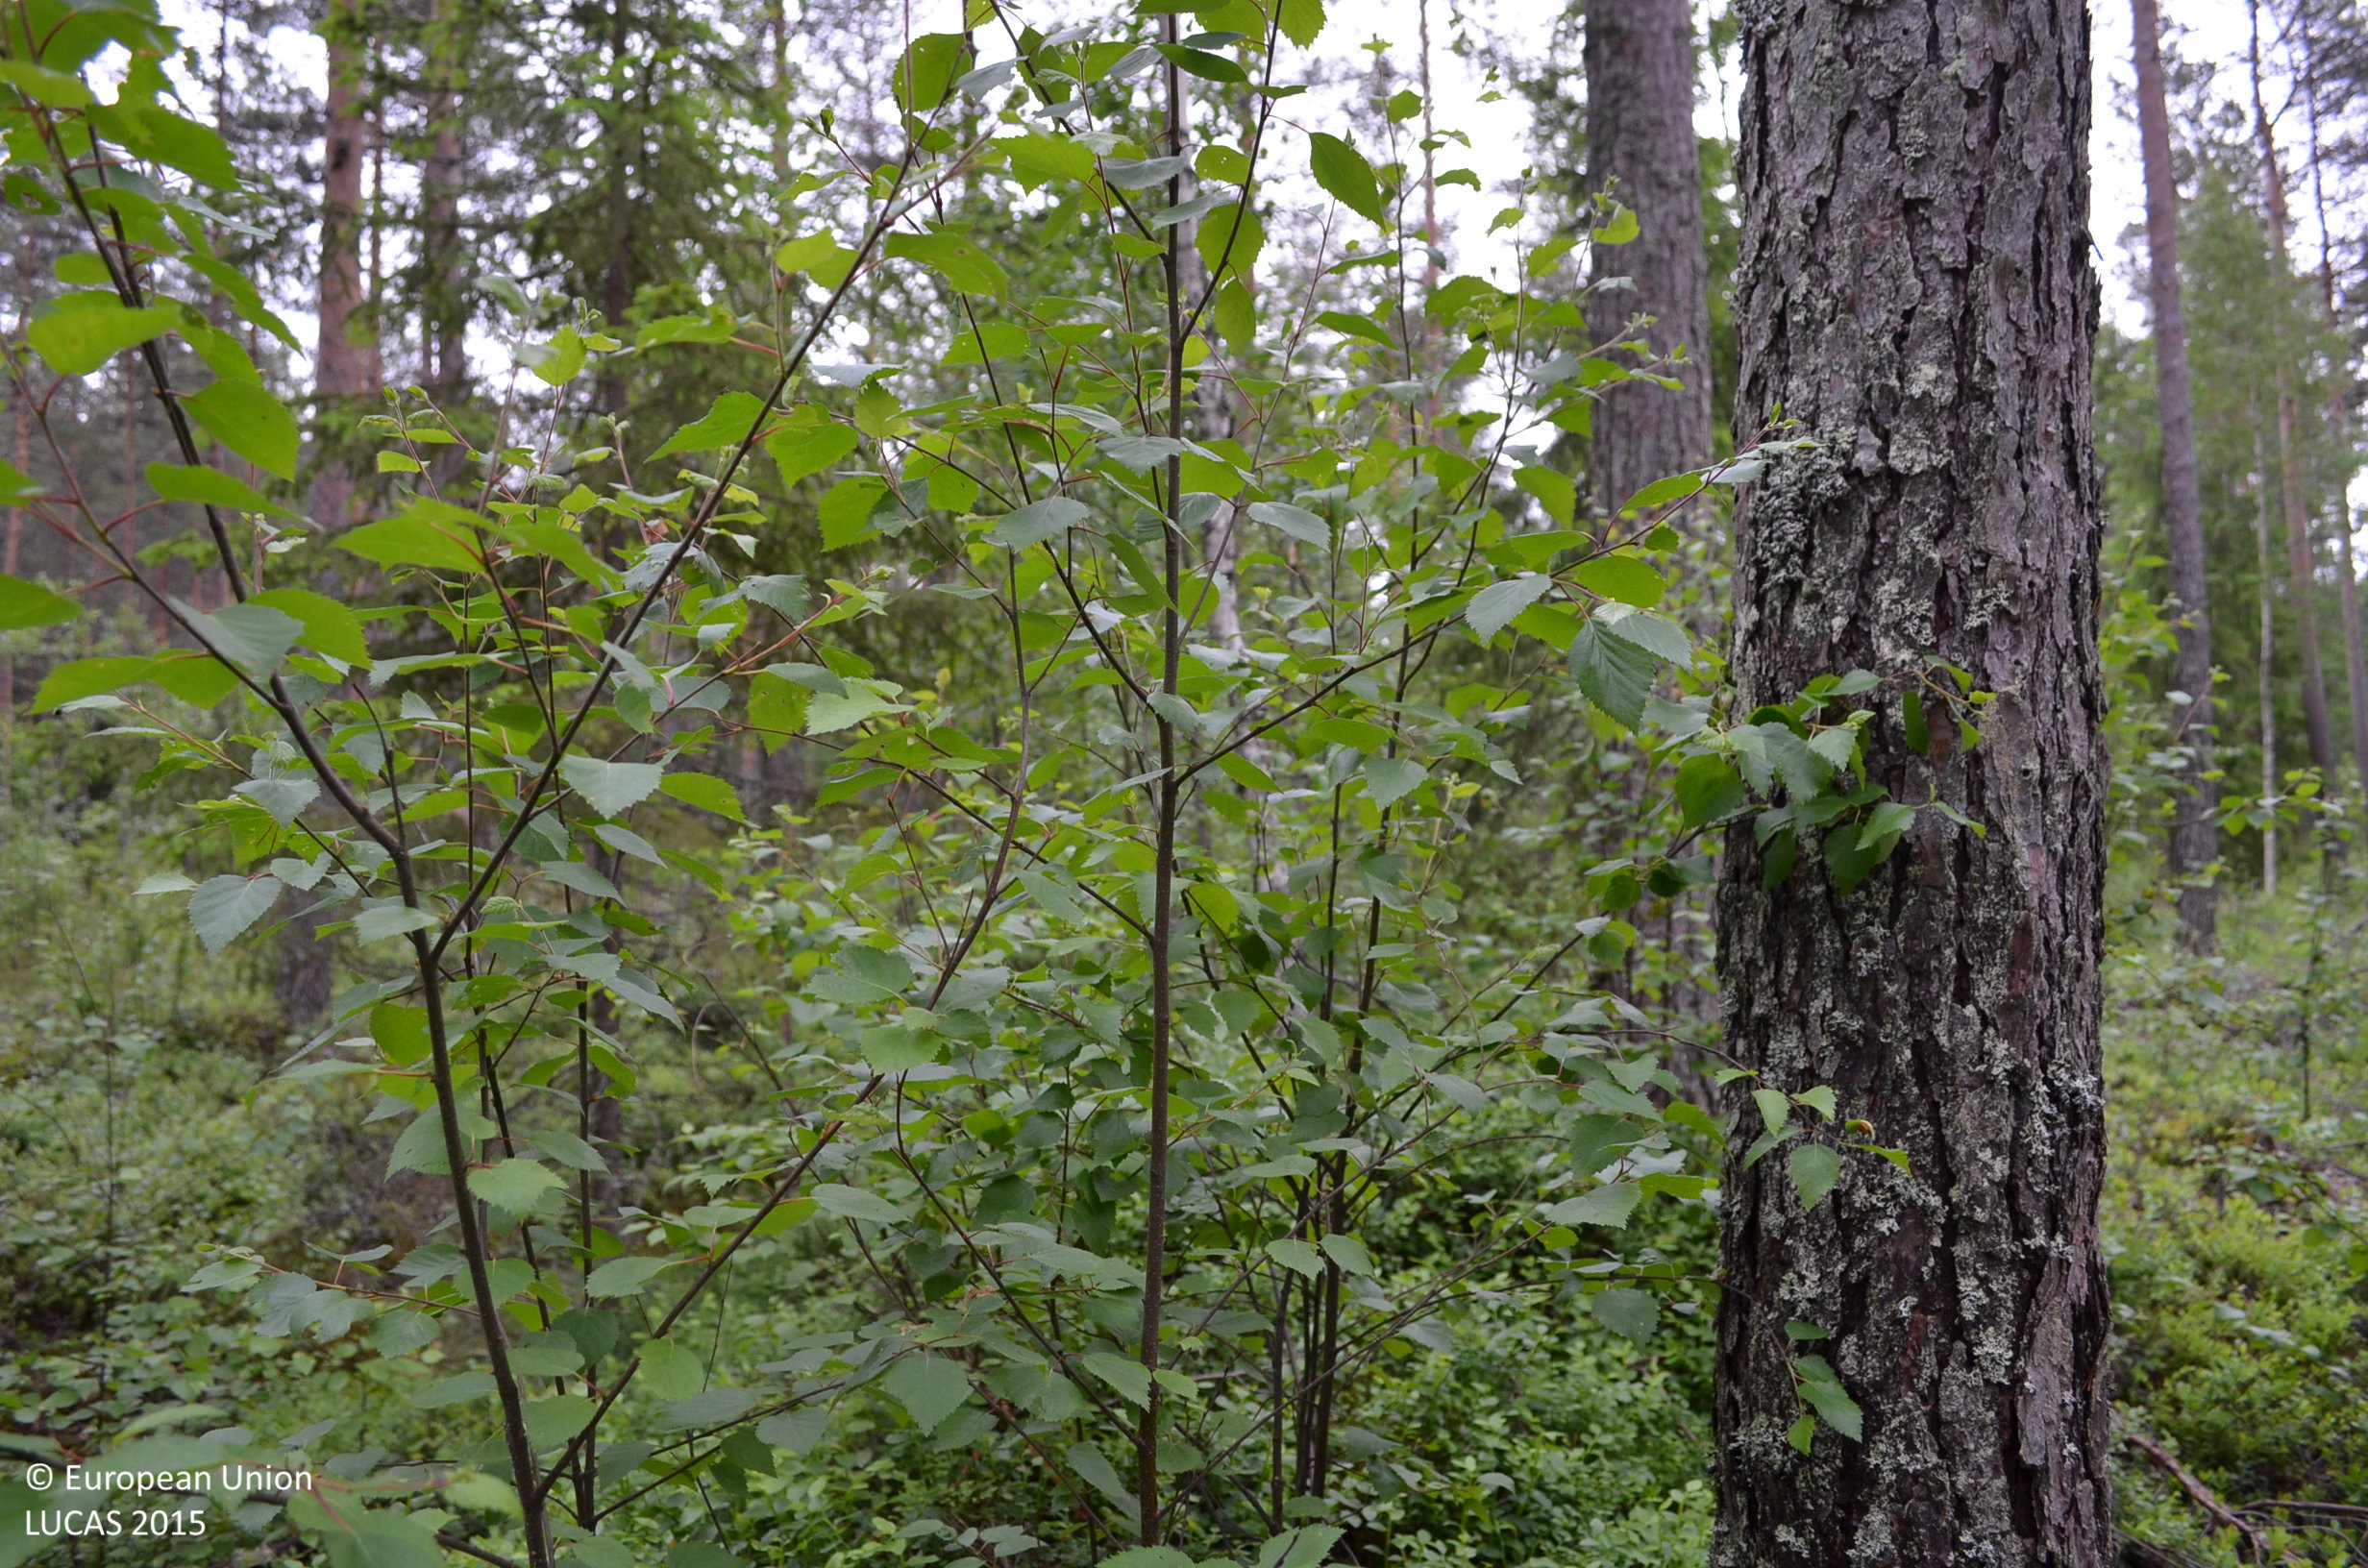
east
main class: Woodland
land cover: Other mixed woodland
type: boreal forest
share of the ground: 50 - 75 %
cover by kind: coniferous forest trees 50 %, shrubs 25 %, broadleaved forest trees 20 %
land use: Forestry
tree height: > 5 m
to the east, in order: Other mixed woodland; Ditches and canals; Pine dominated coniferous woodland; Other mixed woodland; Ditches and canals; Spruce dominated coniferous woodland; Spruce dominated mixed woodland; Ditches and canals; Spruce dominated mixed woodland
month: June
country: FI
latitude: 61.6516
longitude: 23.3088
